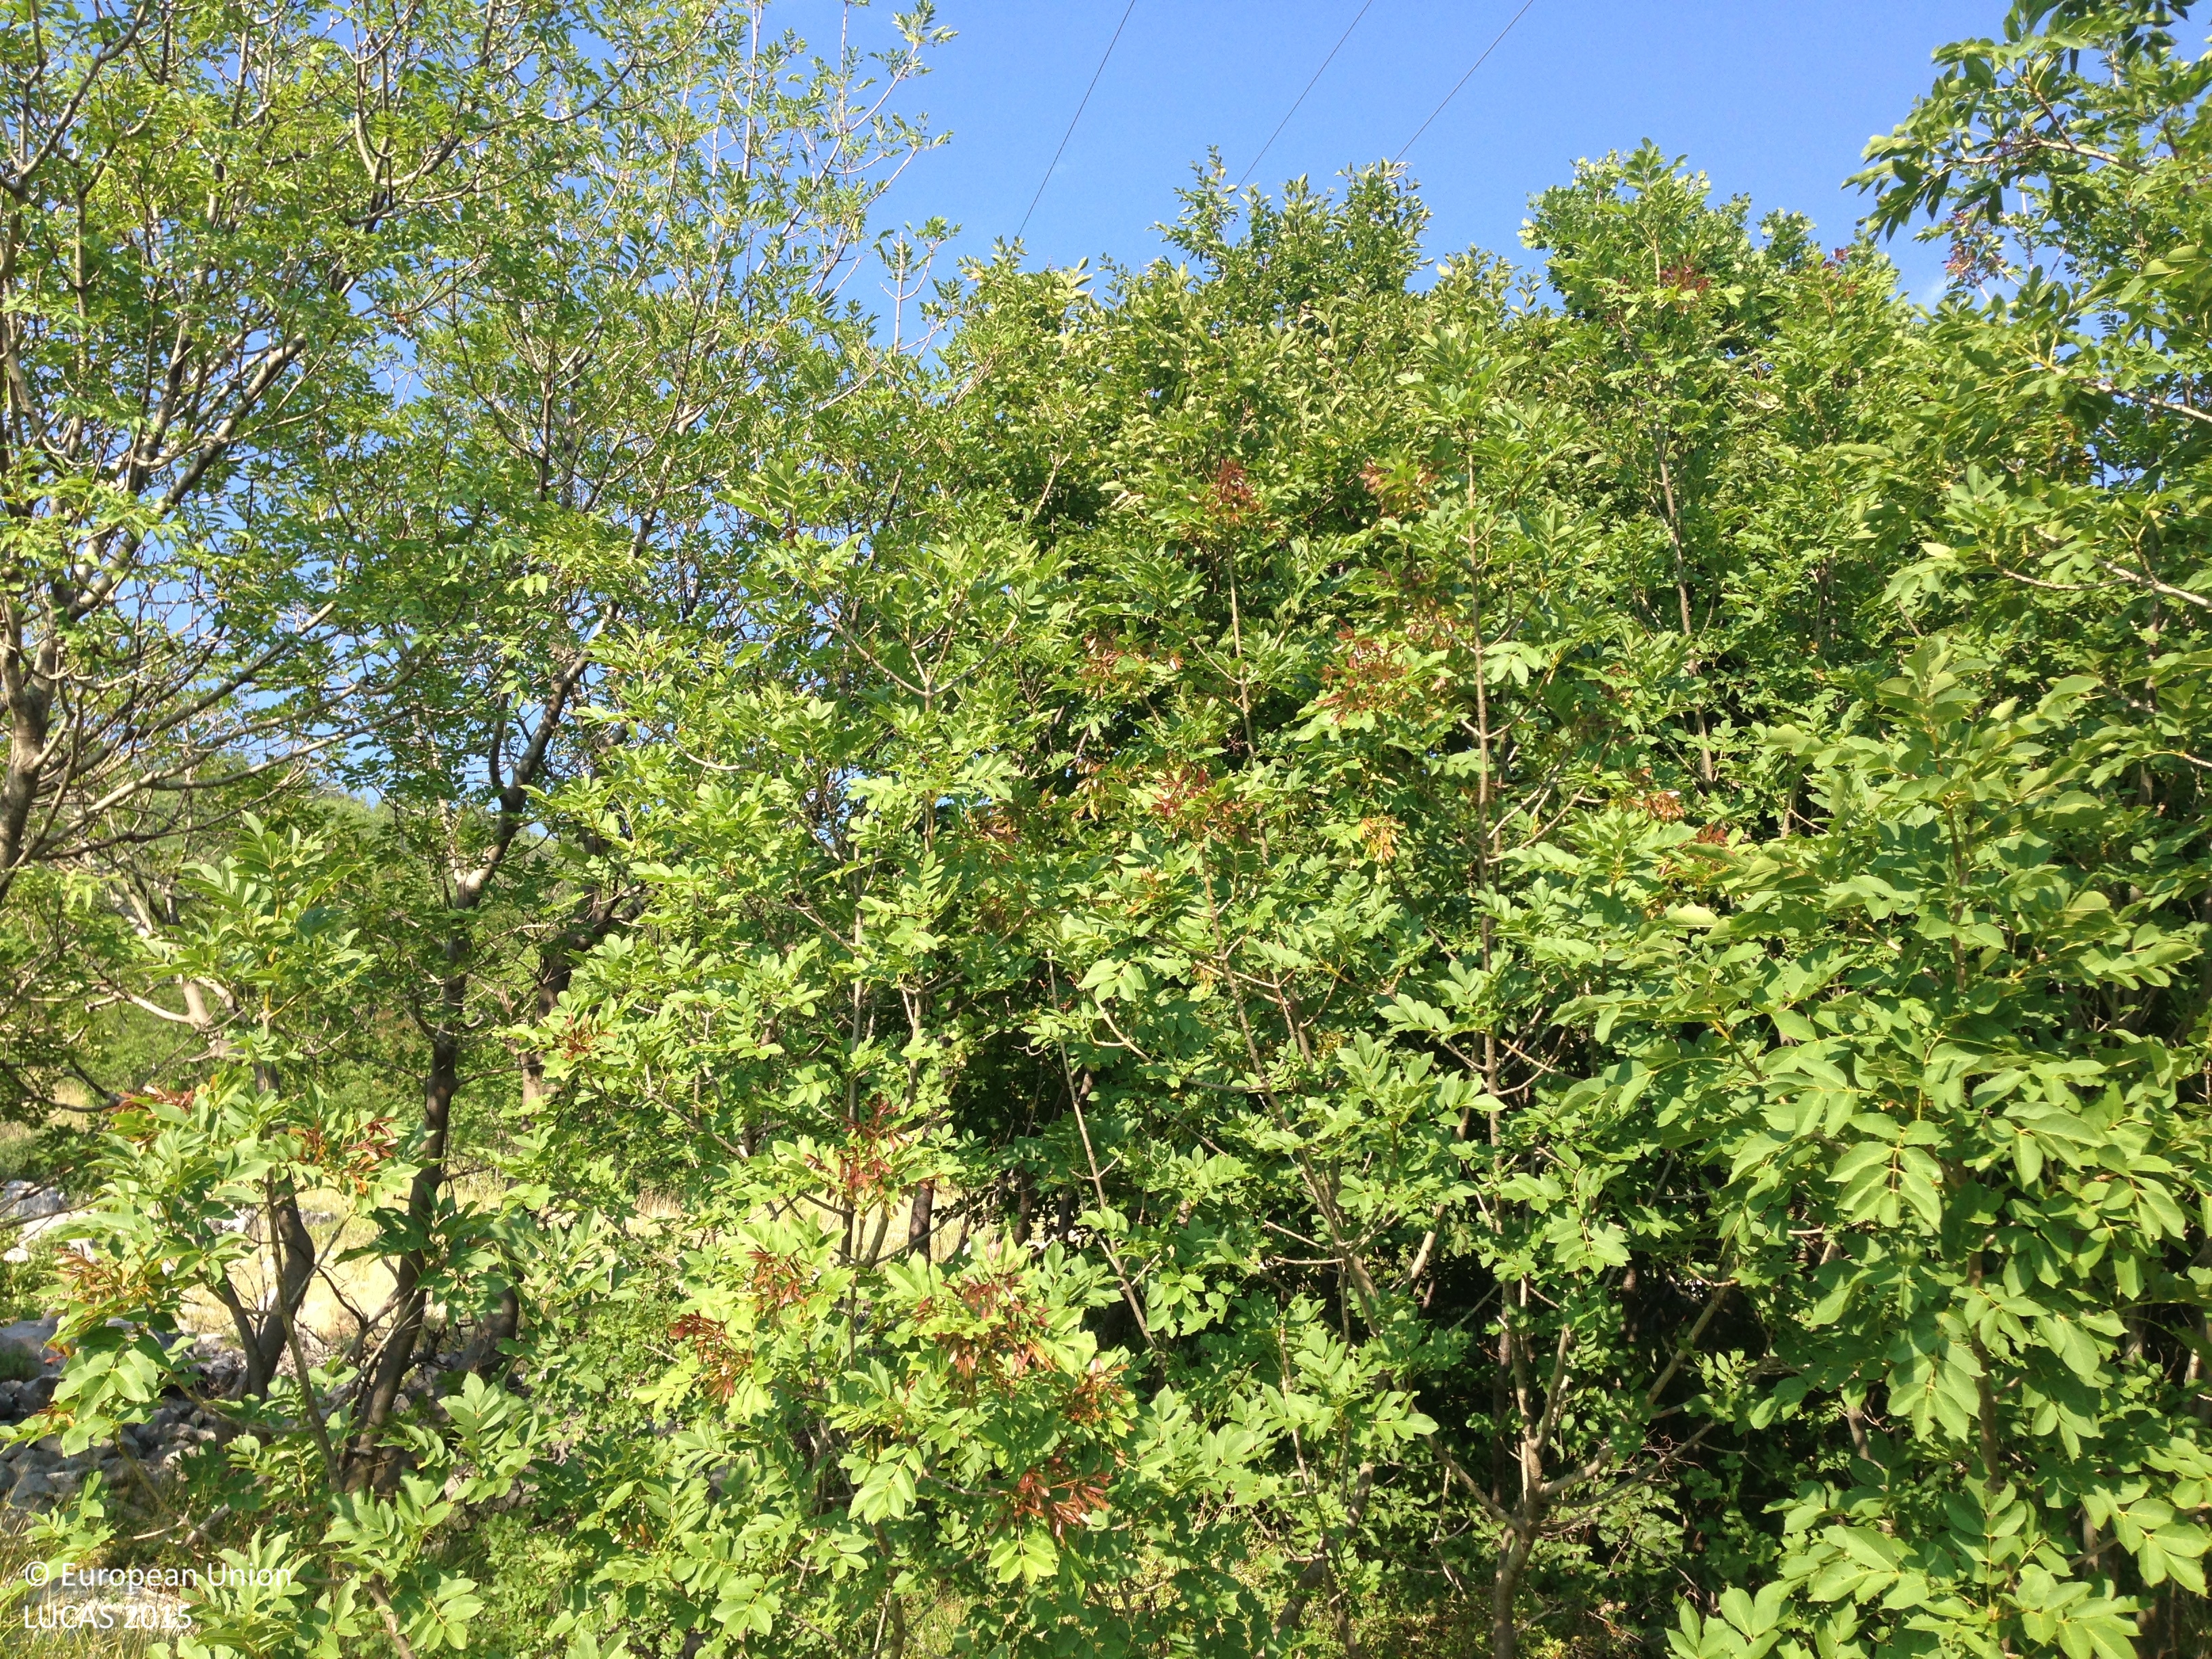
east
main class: Woodland
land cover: Broadleaved woodland
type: thermophilous deciduous forest
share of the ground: > 75 %
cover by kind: broadleaved forest trees 35 %, herbaceous plants 30 %, consolidated bare surface 15 %, shrubs 10 %, unconsolidated bare surface 10 %
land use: Forestry
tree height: < 5 m
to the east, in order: Broadleaved woodland; Electric lines; Tracks; Broadleaved woodland; Electric lines; Broadleaved woodland; Shrubland with sparse tree cover
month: July
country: HR
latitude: 44.5316
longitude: 15.1148
